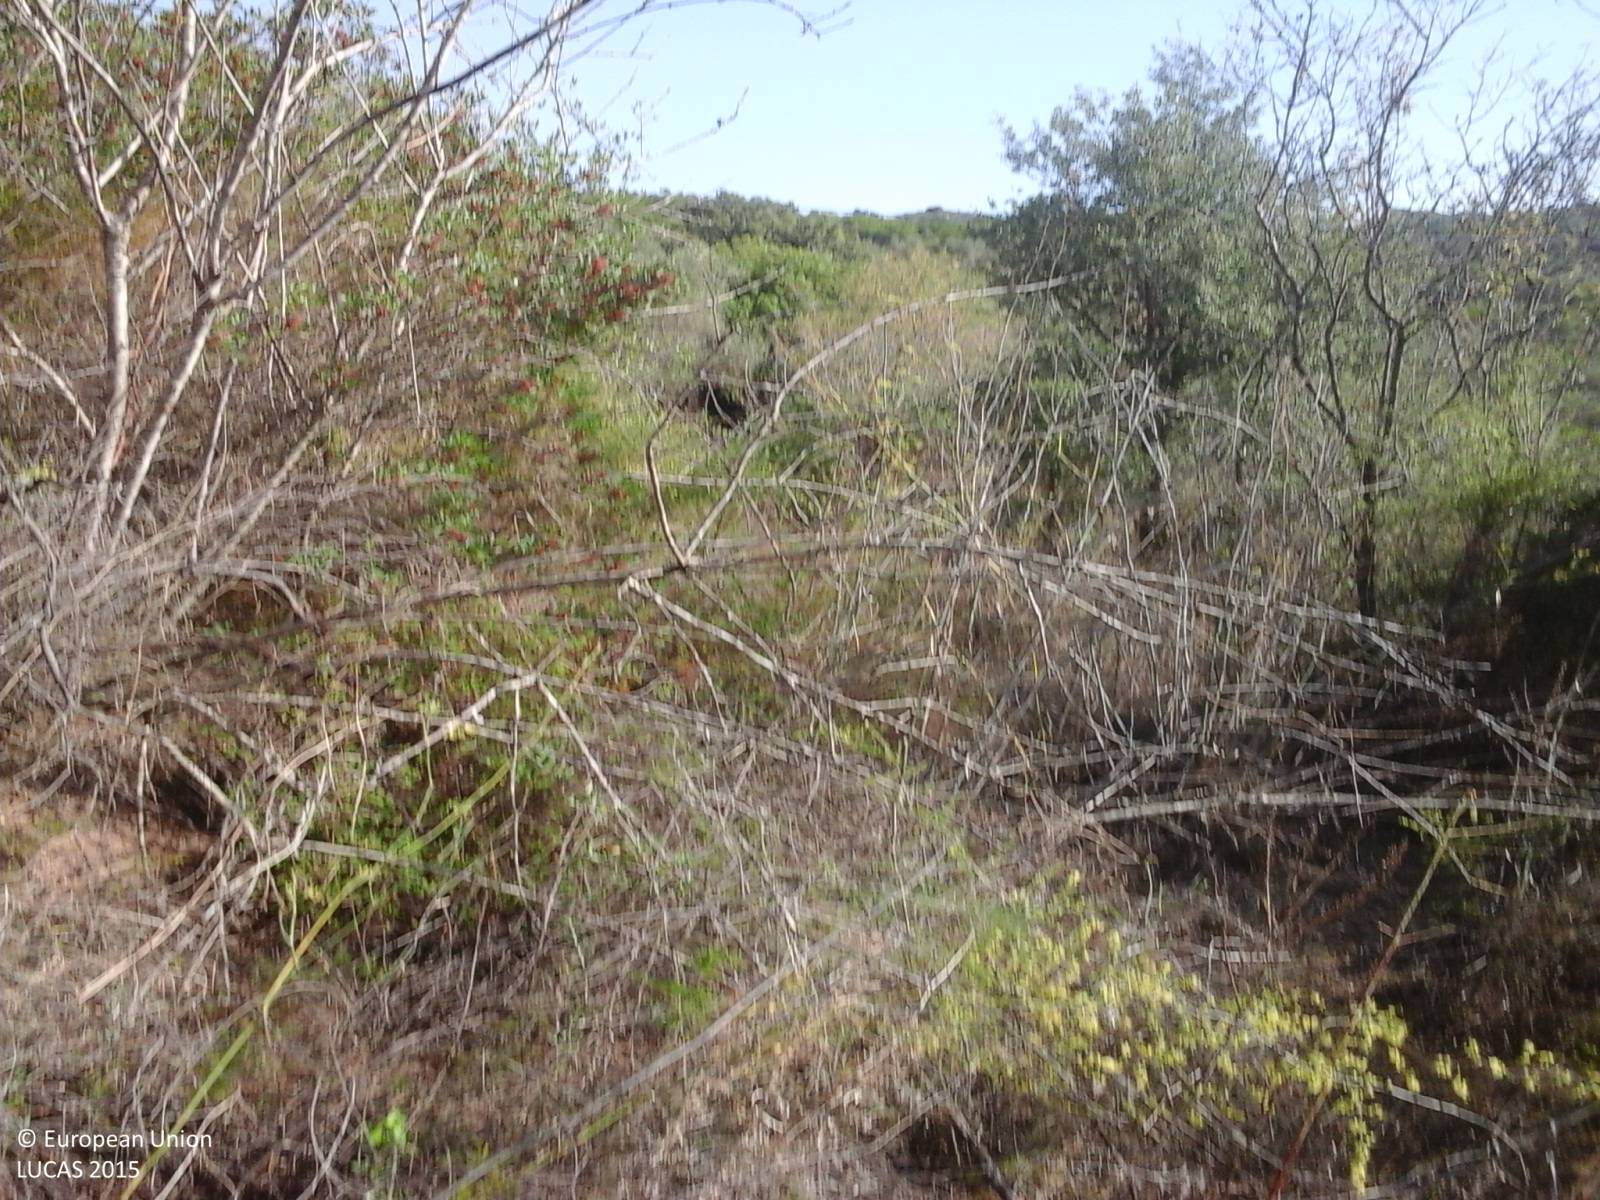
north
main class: Shrubland
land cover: Shrubland with sparse tree cover
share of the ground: > 75 %
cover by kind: shrubs 70 %, herbaceous plants 15 %, unconsolidated bare surface 10 %, broadleaved forest trees 5 %
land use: Semi-natural and natural areas not in use
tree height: > 5 m
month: September
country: IT
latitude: 39.9767
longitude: 9.5691
